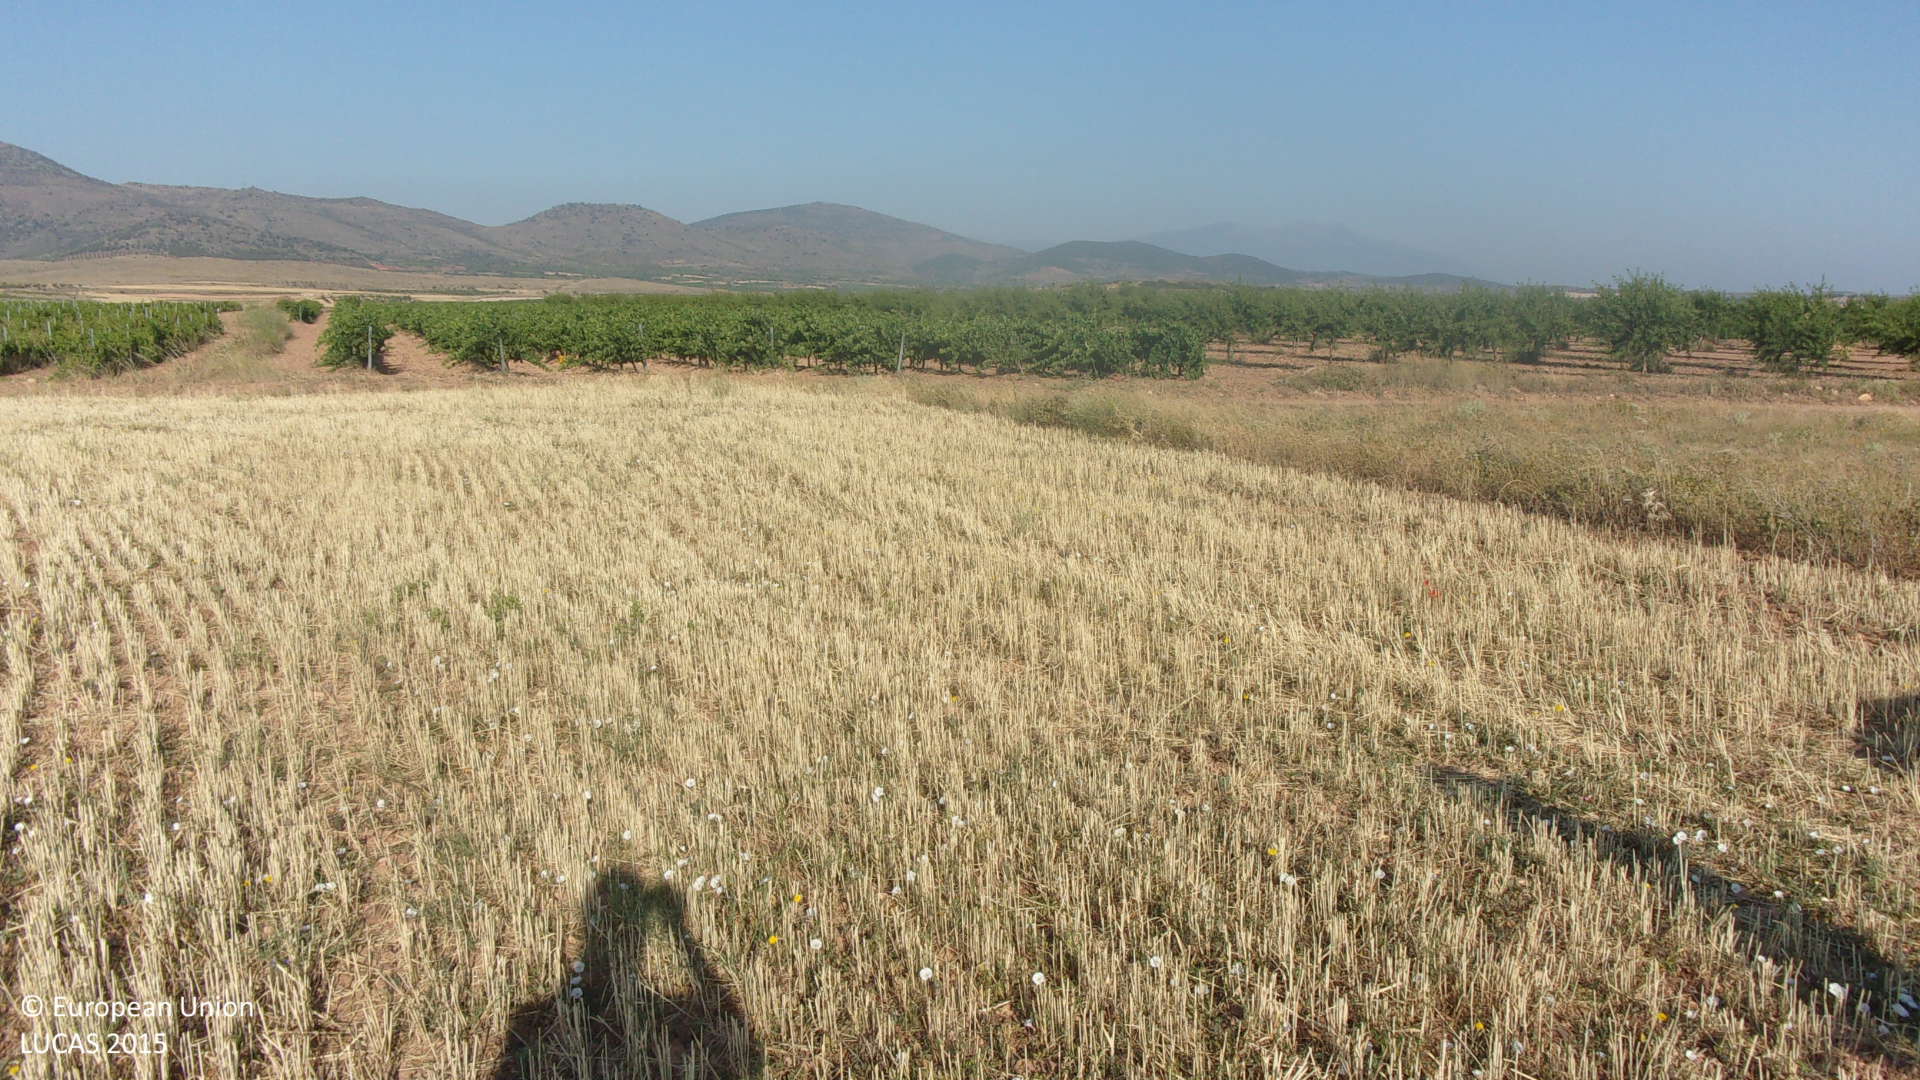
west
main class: Cropland
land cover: Barley
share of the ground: < 10 %
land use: Agriculture (excluding fallow land and kitchen gardens)
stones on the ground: 10 - 25 %
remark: Harvested field
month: July
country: ES
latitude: 41.7279
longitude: -1.4600
